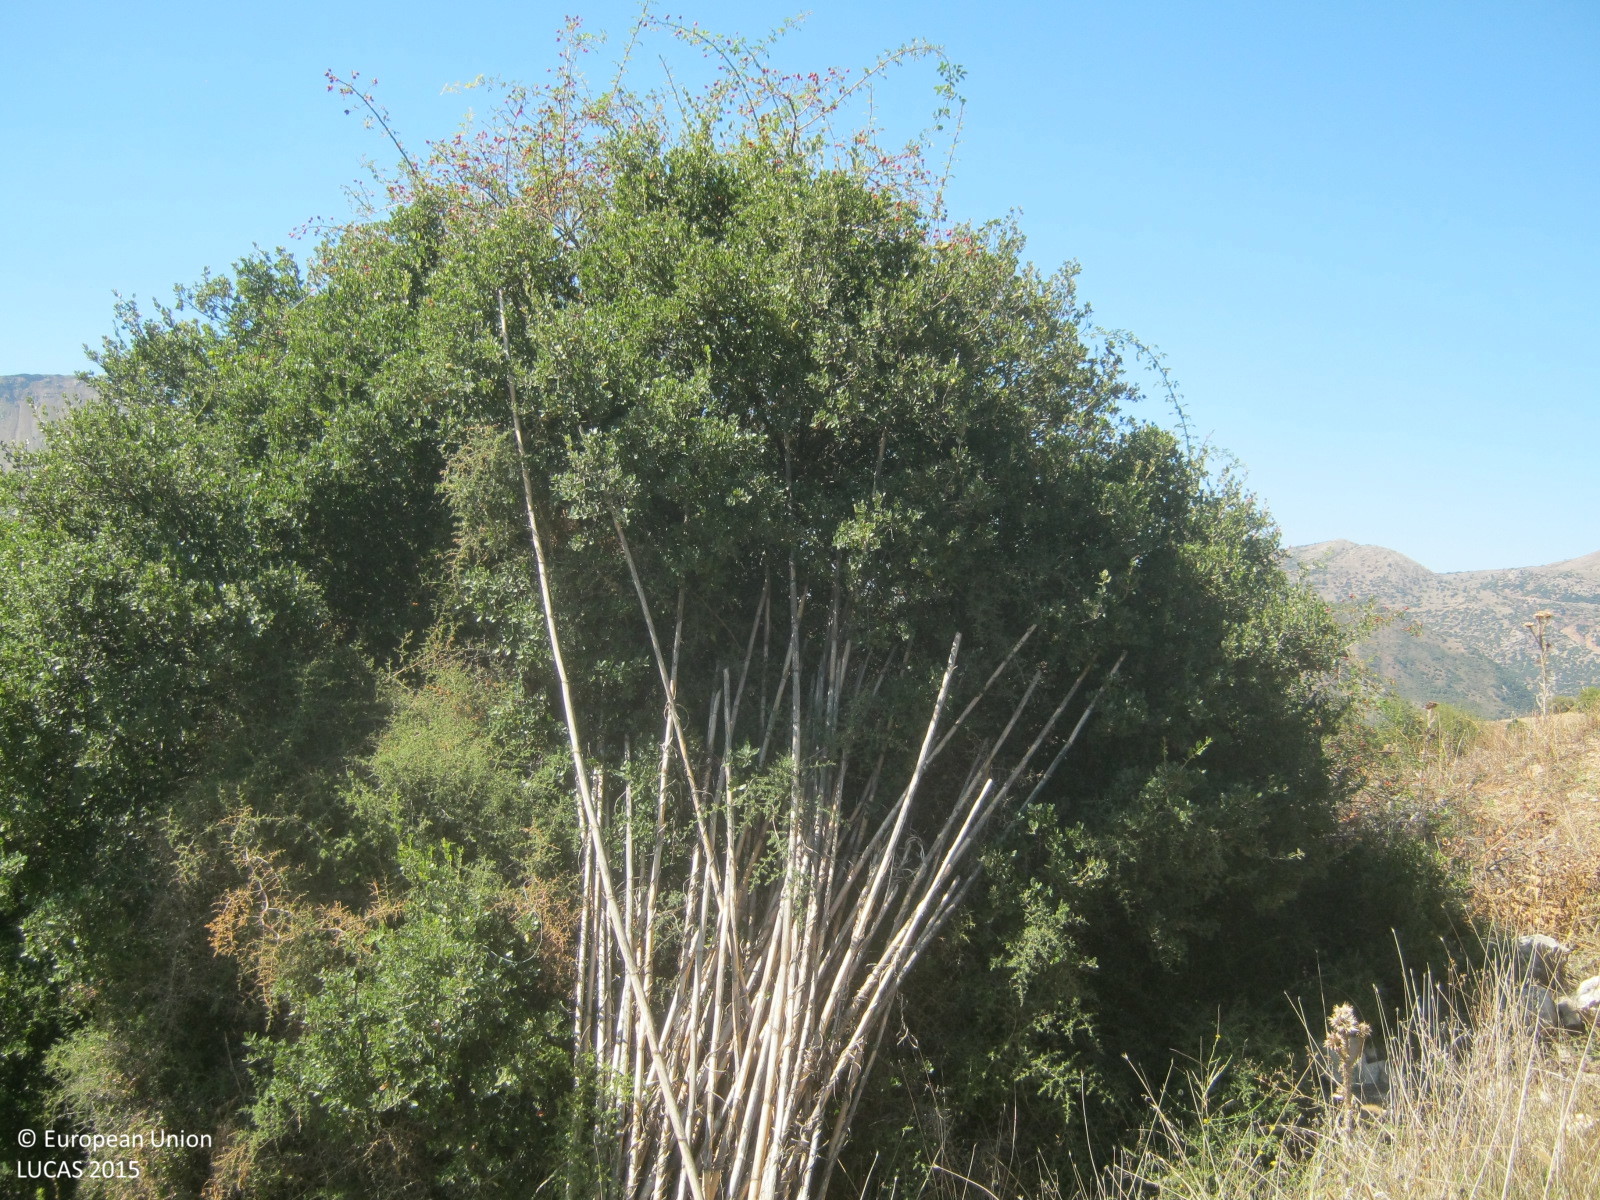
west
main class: Grassland
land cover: Spontaneously vegetated surfaces
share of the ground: 50 - 75 %
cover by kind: herbaceous plants 50 %, unconsolidated bare surface 50 %
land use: Fallow land
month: September
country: GR
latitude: 38.1233
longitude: 22.1169
